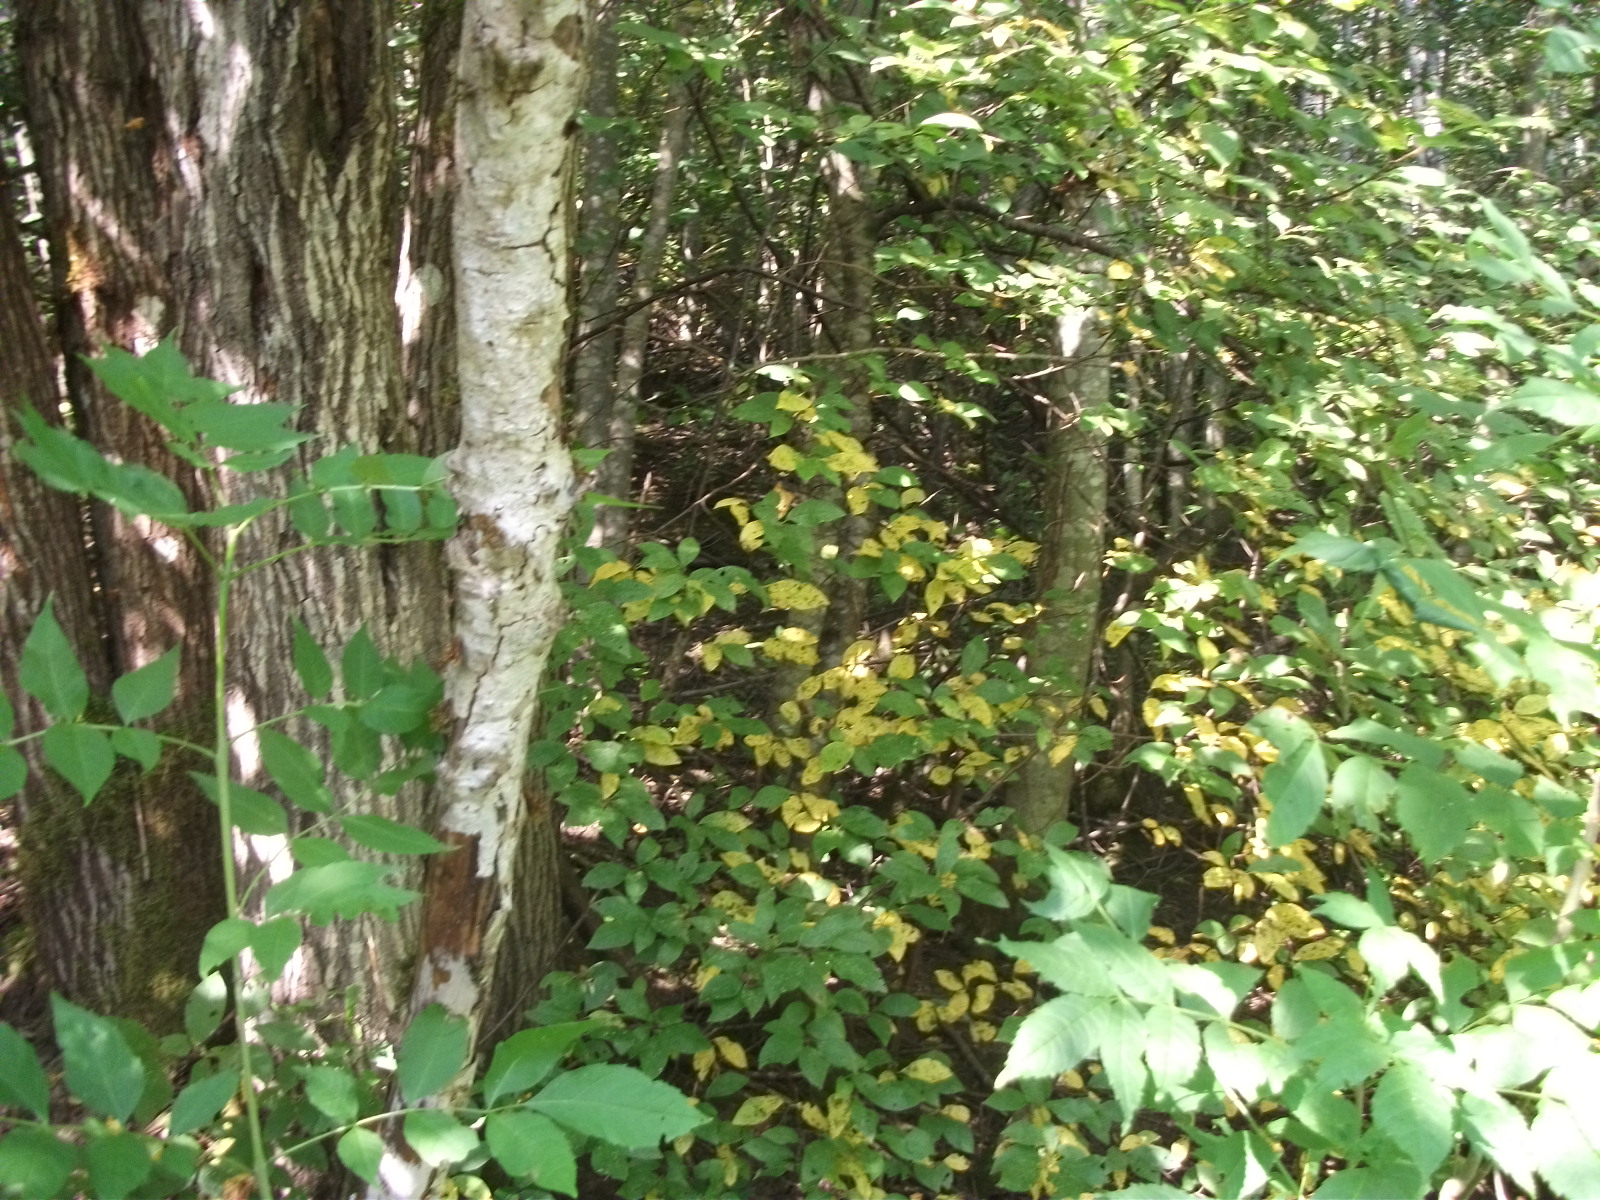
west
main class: Woodland
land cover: Broadleaved woodland
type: non-riverine alder, birch or aspen forest
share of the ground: 50 - 75 %
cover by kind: broadleaved forest trees 70 %, shrubs 10 %, herbaceous plants 10 %, unconsolidated bare surface 5 %
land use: Forestry
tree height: > 5 m
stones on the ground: < 10 %
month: August
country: LV
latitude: 56.8256
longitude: 25.5726
